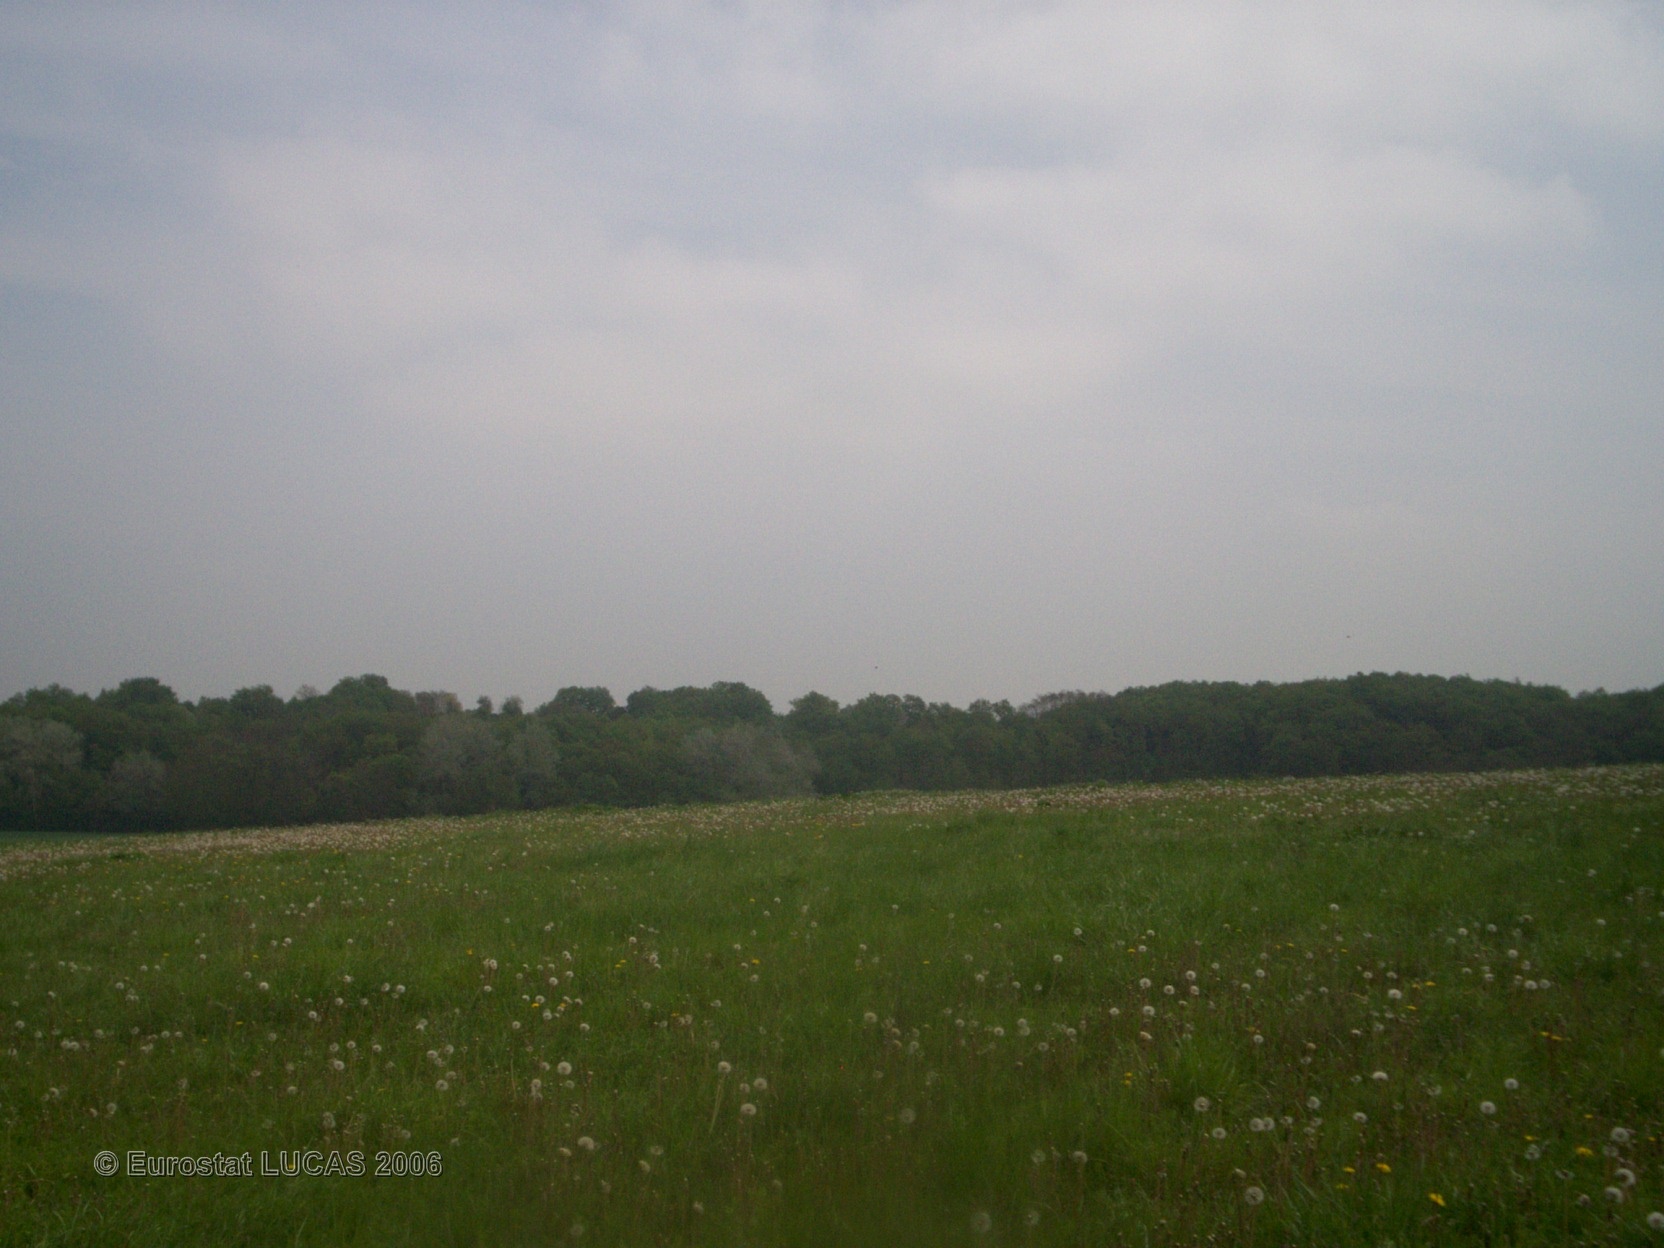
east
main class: Grassland
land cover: Grassland without tree/shrub cover
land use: Fallow land
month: May
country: FR
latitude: 47.9282
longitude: 2.9932
